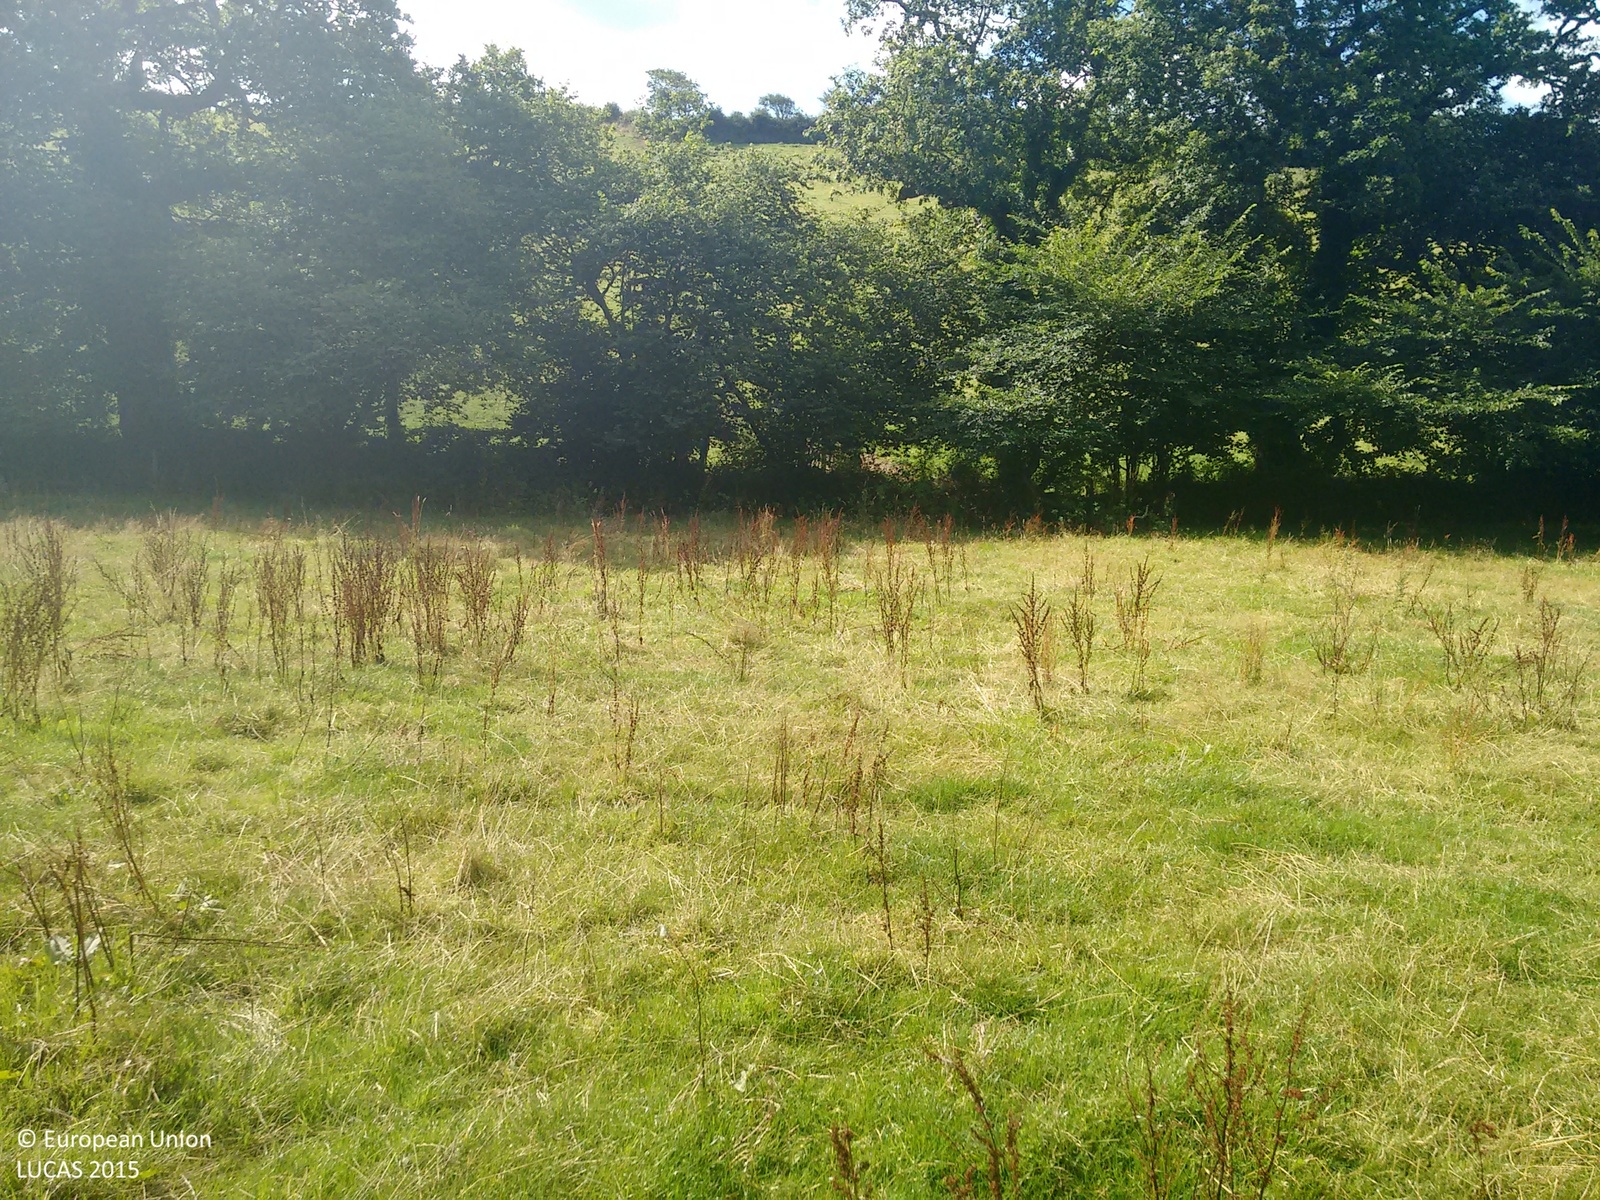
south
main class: Grassland
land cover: Grassland without tree/shrub cover
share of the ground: > 75 %
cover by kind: herbaceous plants 100 %
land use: Agriculture (excluding fallow land and kitchen gardens)
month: August
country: GB
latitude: 50.2961
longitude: -4.8949
